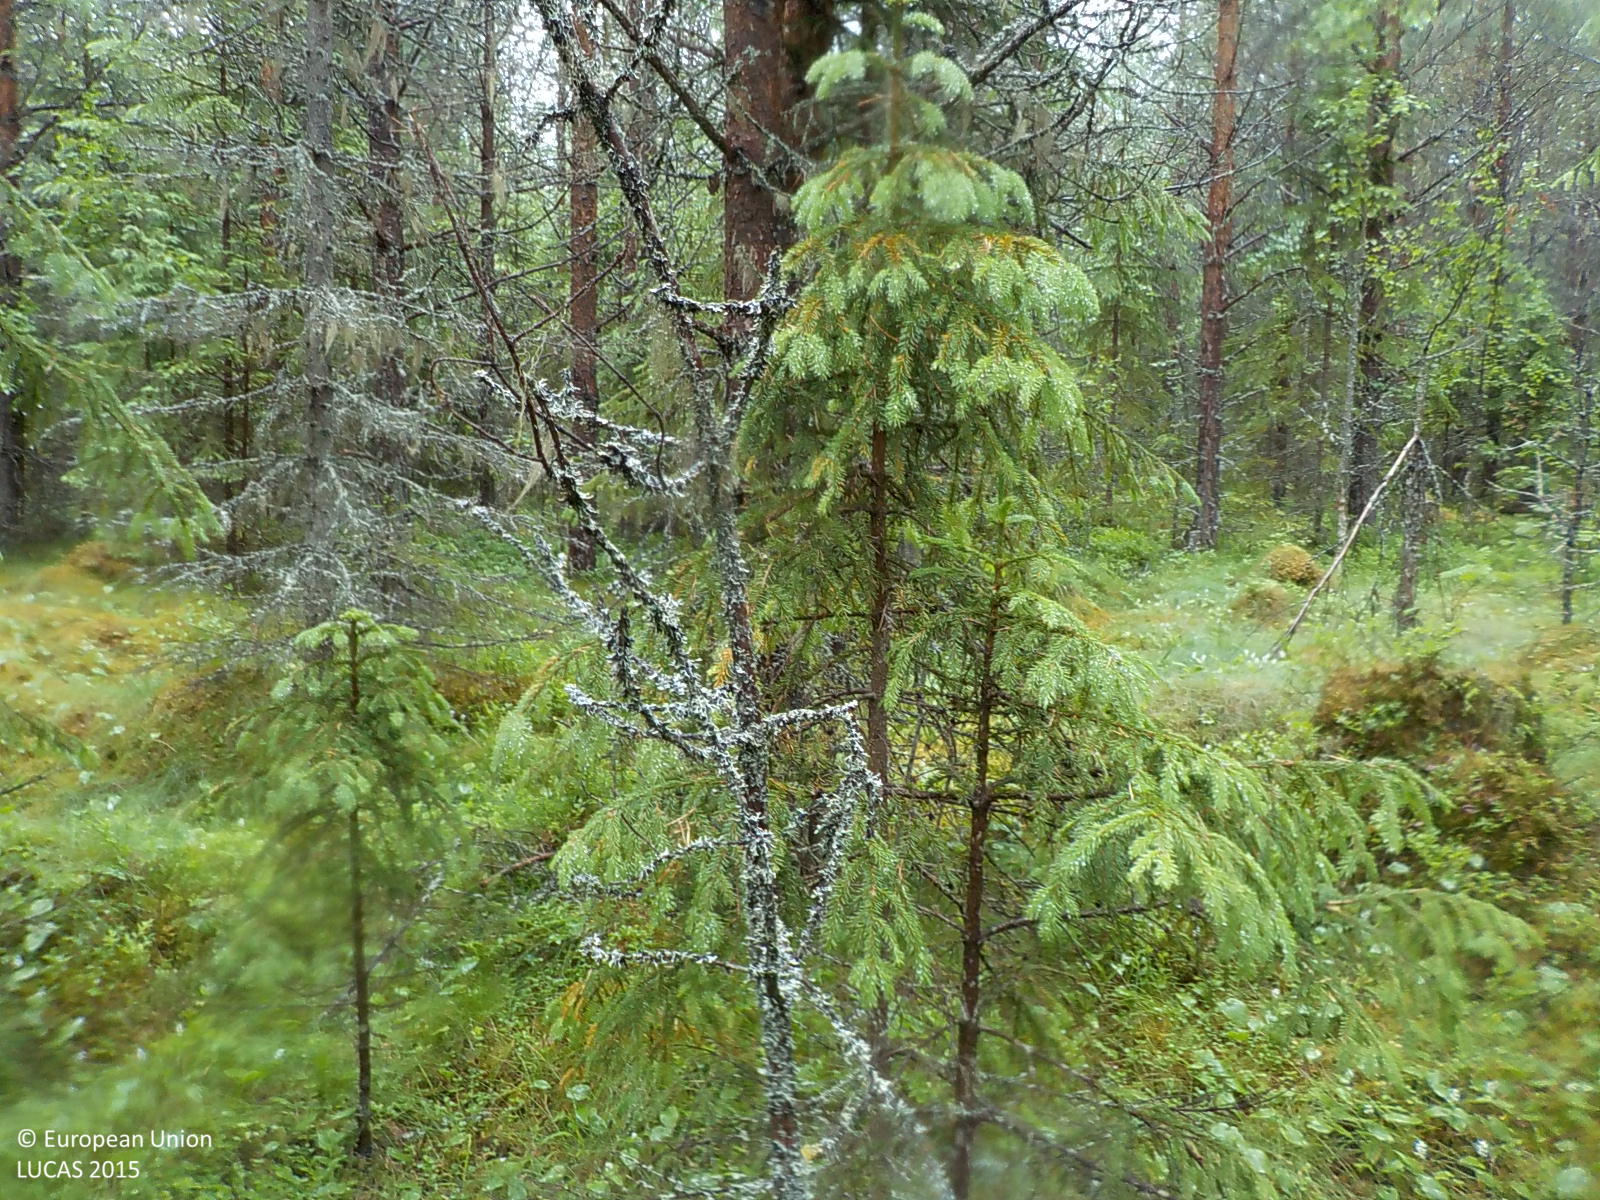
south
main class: Woodland
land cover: Pine dominated coniferous woodland
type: boreal forest
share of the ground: > 75 %
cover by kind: coniferous forest trees 75 %, lichens and mosses 15 %, shrubs 5 %, herbaceous plants 5 %
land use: Forestry
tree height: > 5 m
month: July
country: SE
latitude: 63.0151
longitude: 16.9101
